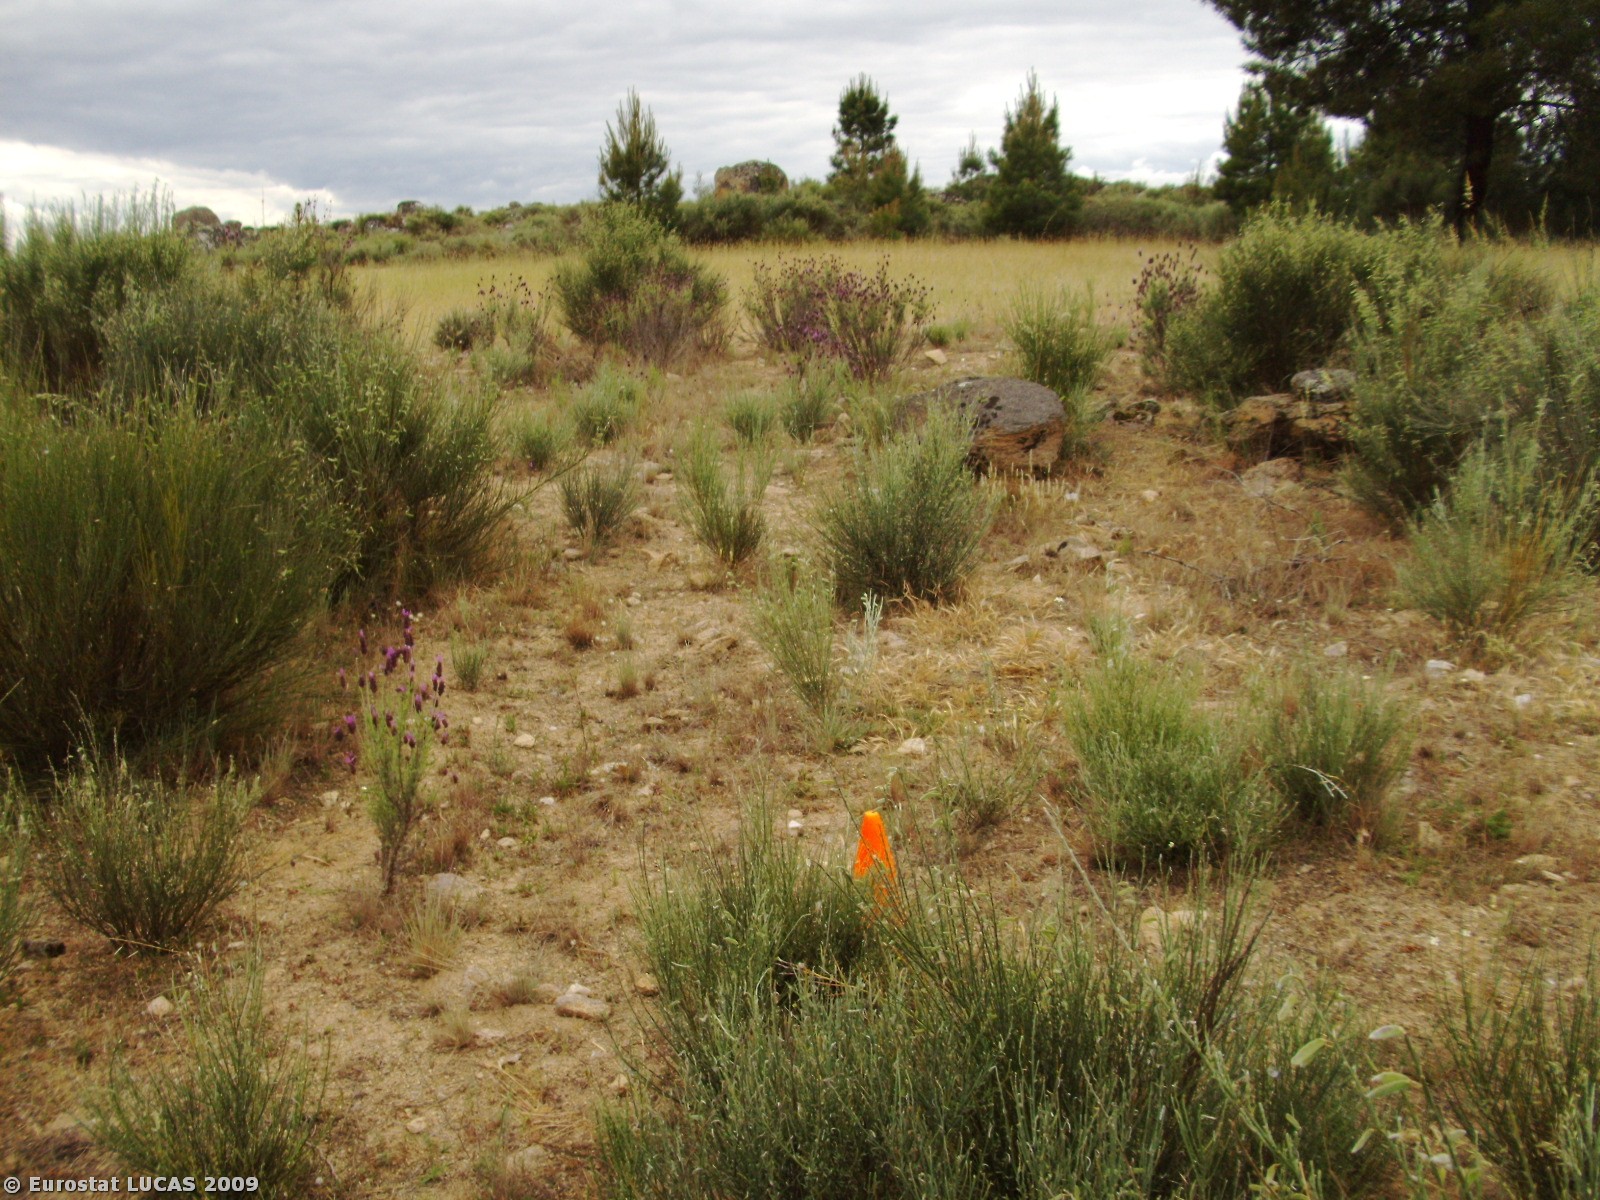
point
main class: Shrubland
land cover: Shrubland without tree cover
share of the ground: 25 - 50 %
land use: Nature reserves
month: May
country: PT
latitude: 40.8989
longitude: -7.1670
